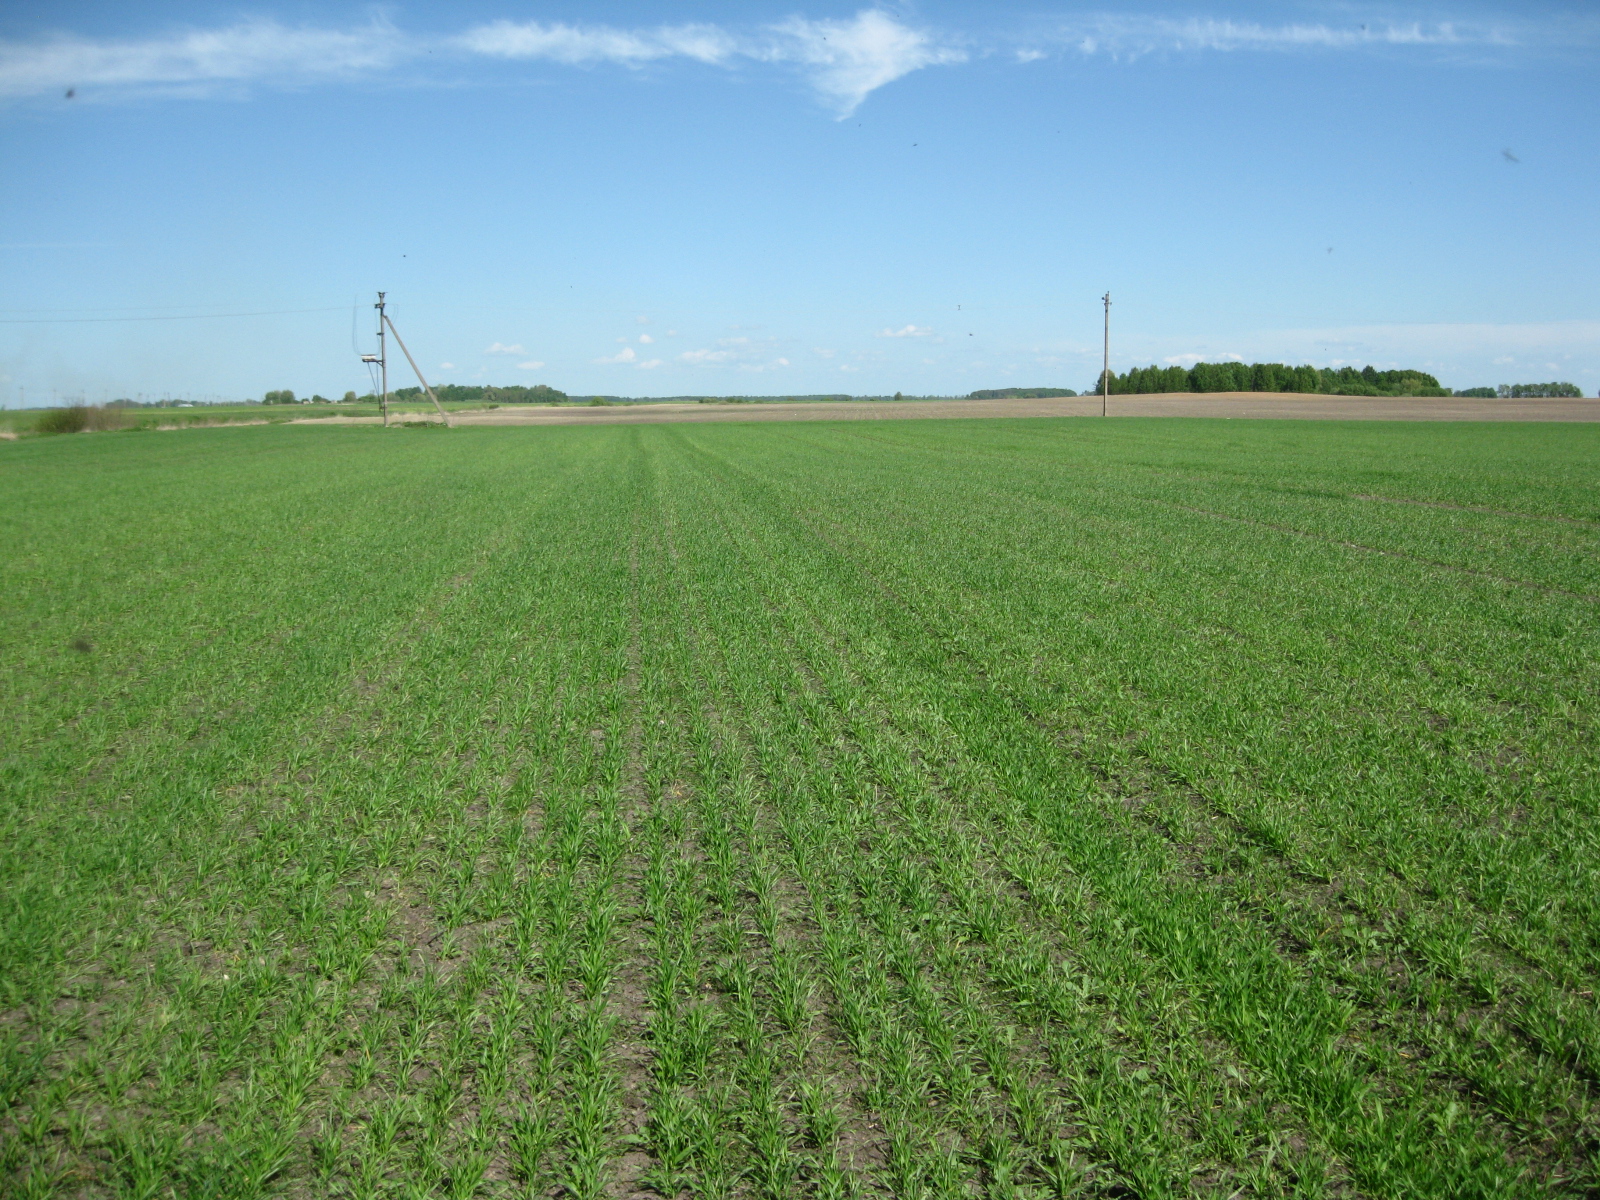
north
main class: Cropland
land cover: Barley
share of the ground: > 75 %
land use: Agriculture (excluding fallow land and kitchen gardens)
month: May
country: LT
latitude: 56.1488
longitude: 24.1421
